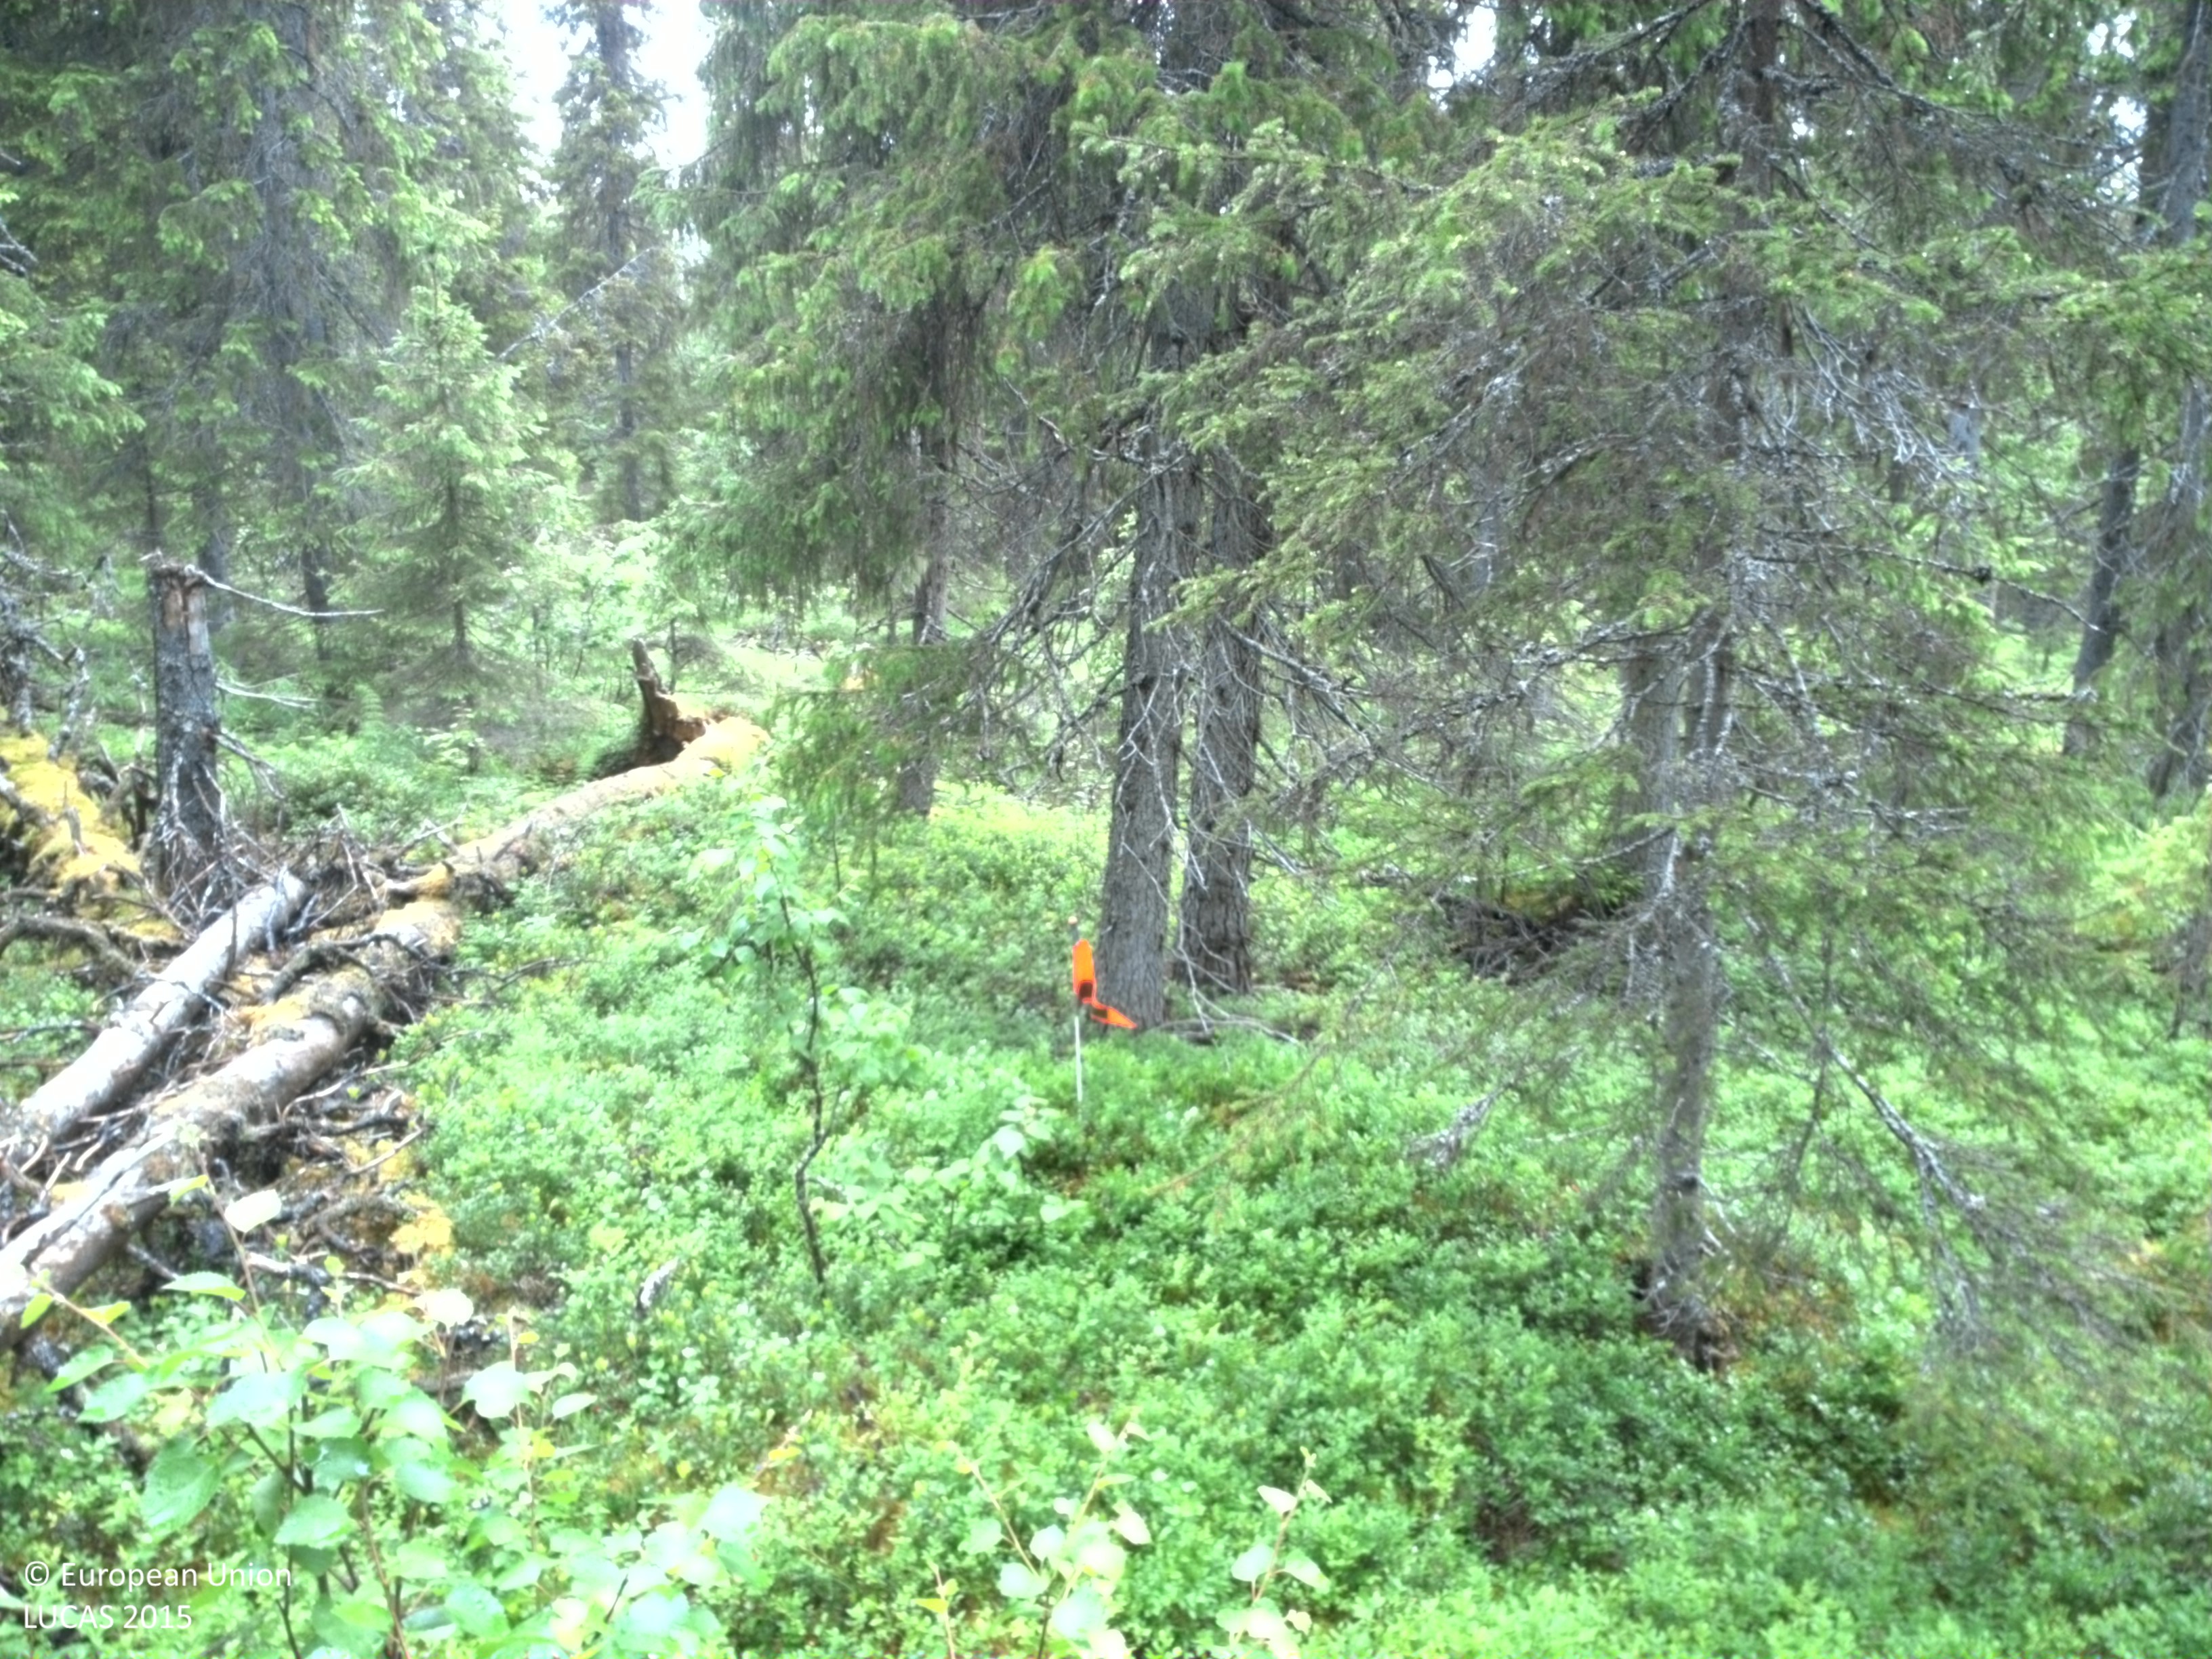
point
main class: Woodland
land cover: Spruce dominated coniferous woodland
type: boreal forest
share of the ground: 25 - 50 %
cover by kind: shrubs 45 %, coniferous forest trees 40 %, lichens and mosses 10 %, herbaceous plants 5 %
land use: Forestry
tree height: > 5 m
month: July
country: SE
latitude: 65.5128
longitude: 15.6075
